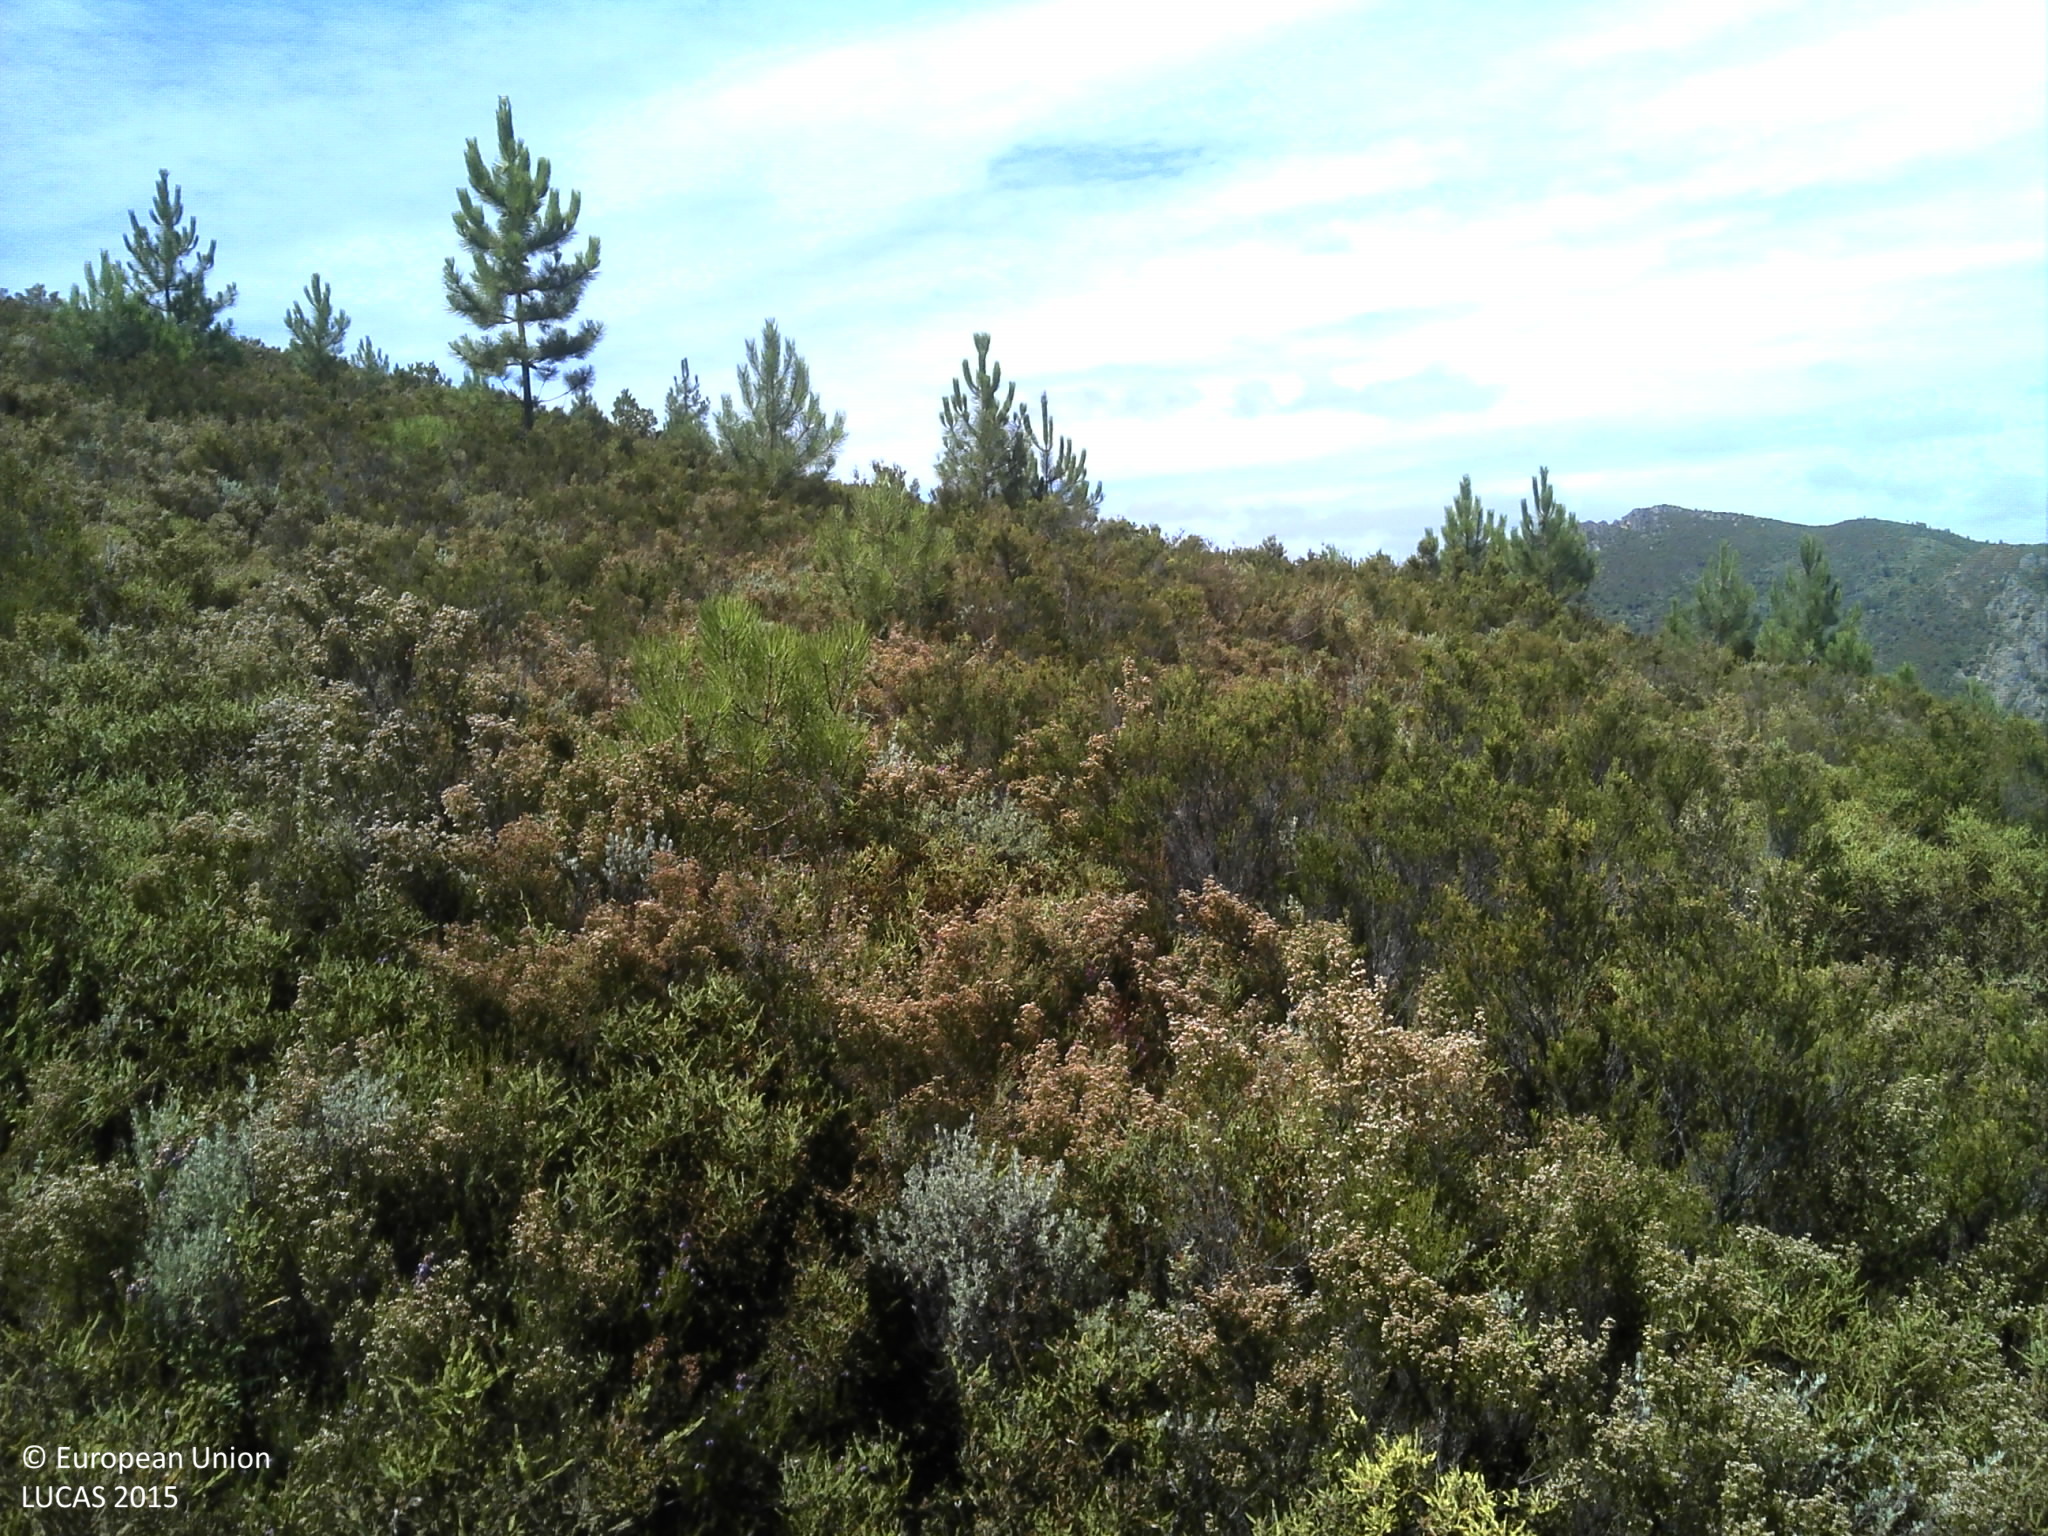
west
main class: Shrubland
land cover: Shrubland without tree cover
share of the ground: > 75 %
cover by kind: shrubs 90 %, unconsolidated bare surface 10 %
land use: Semi-natural and natural areas not in use
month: July
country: PT
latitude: 40.1575
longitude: -7.9018
